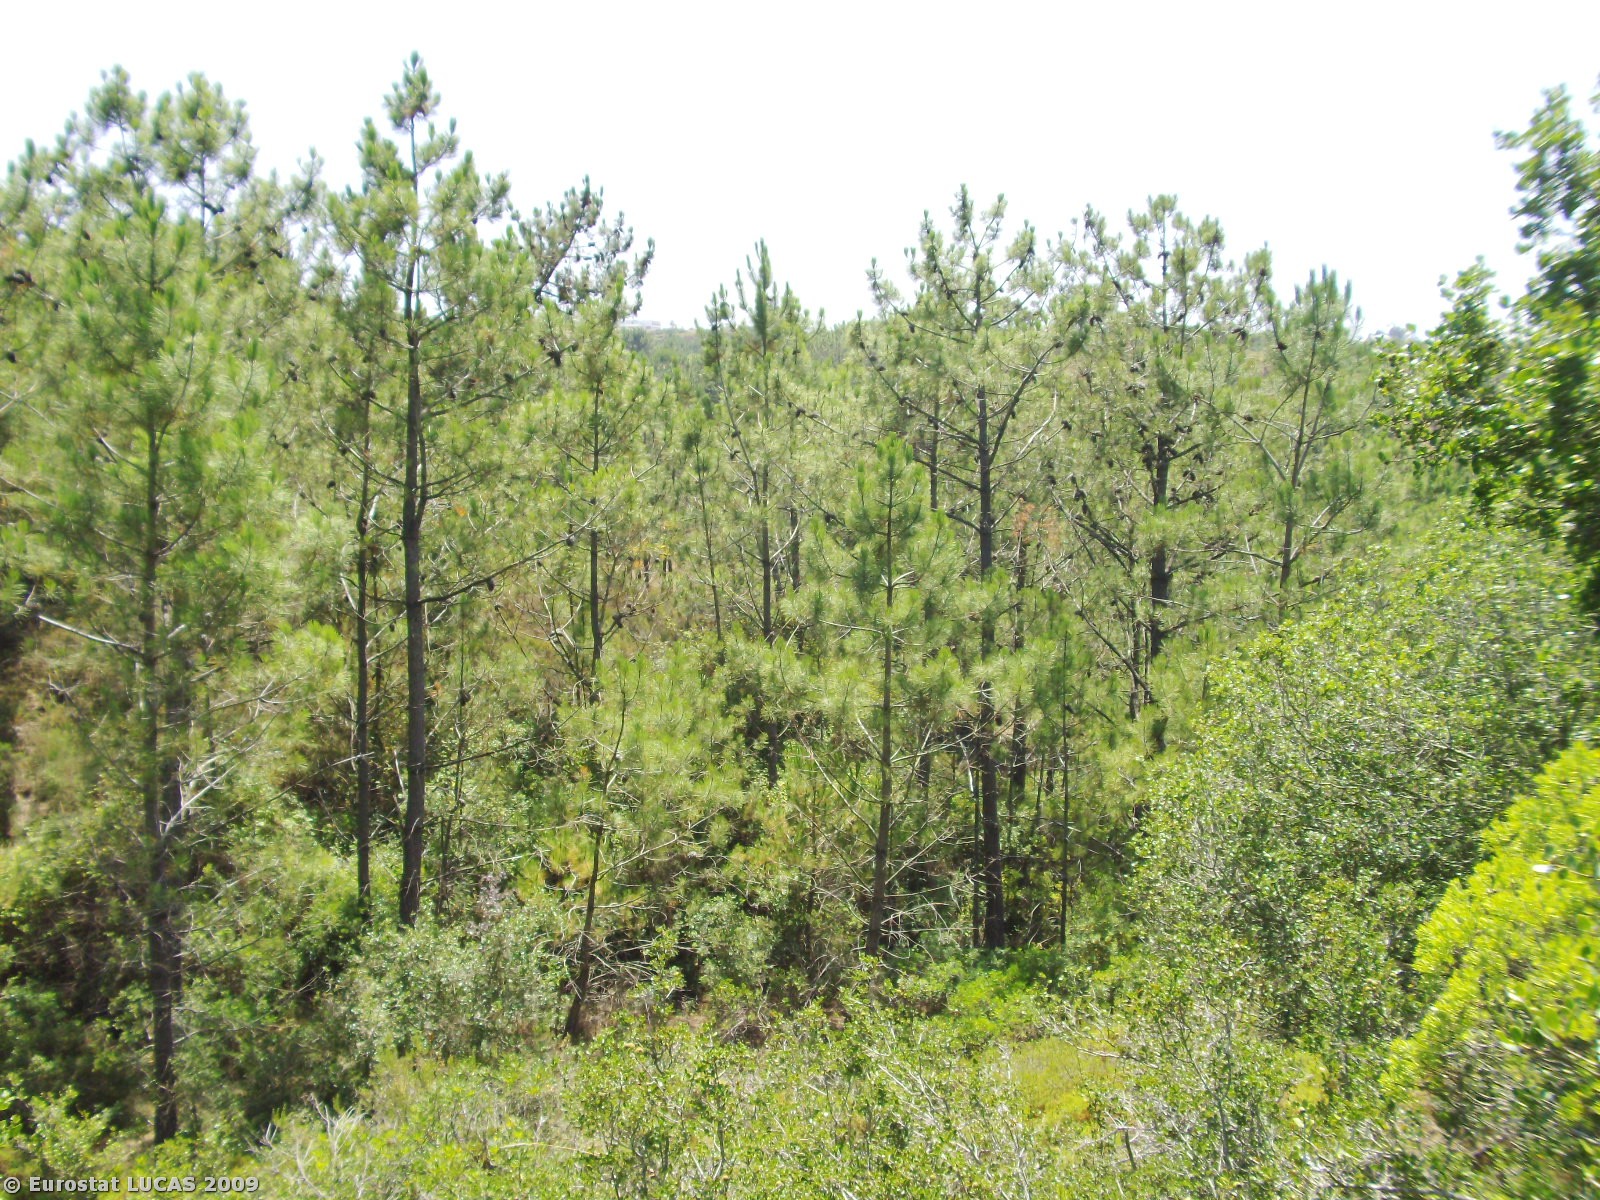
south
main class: Shrubland
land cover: Shrubland with sparse tree cover
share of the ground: > 75 %
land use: Nature reserves
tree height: < 5 m
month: July
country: PT
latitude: 38.4537
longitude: -9.1492
